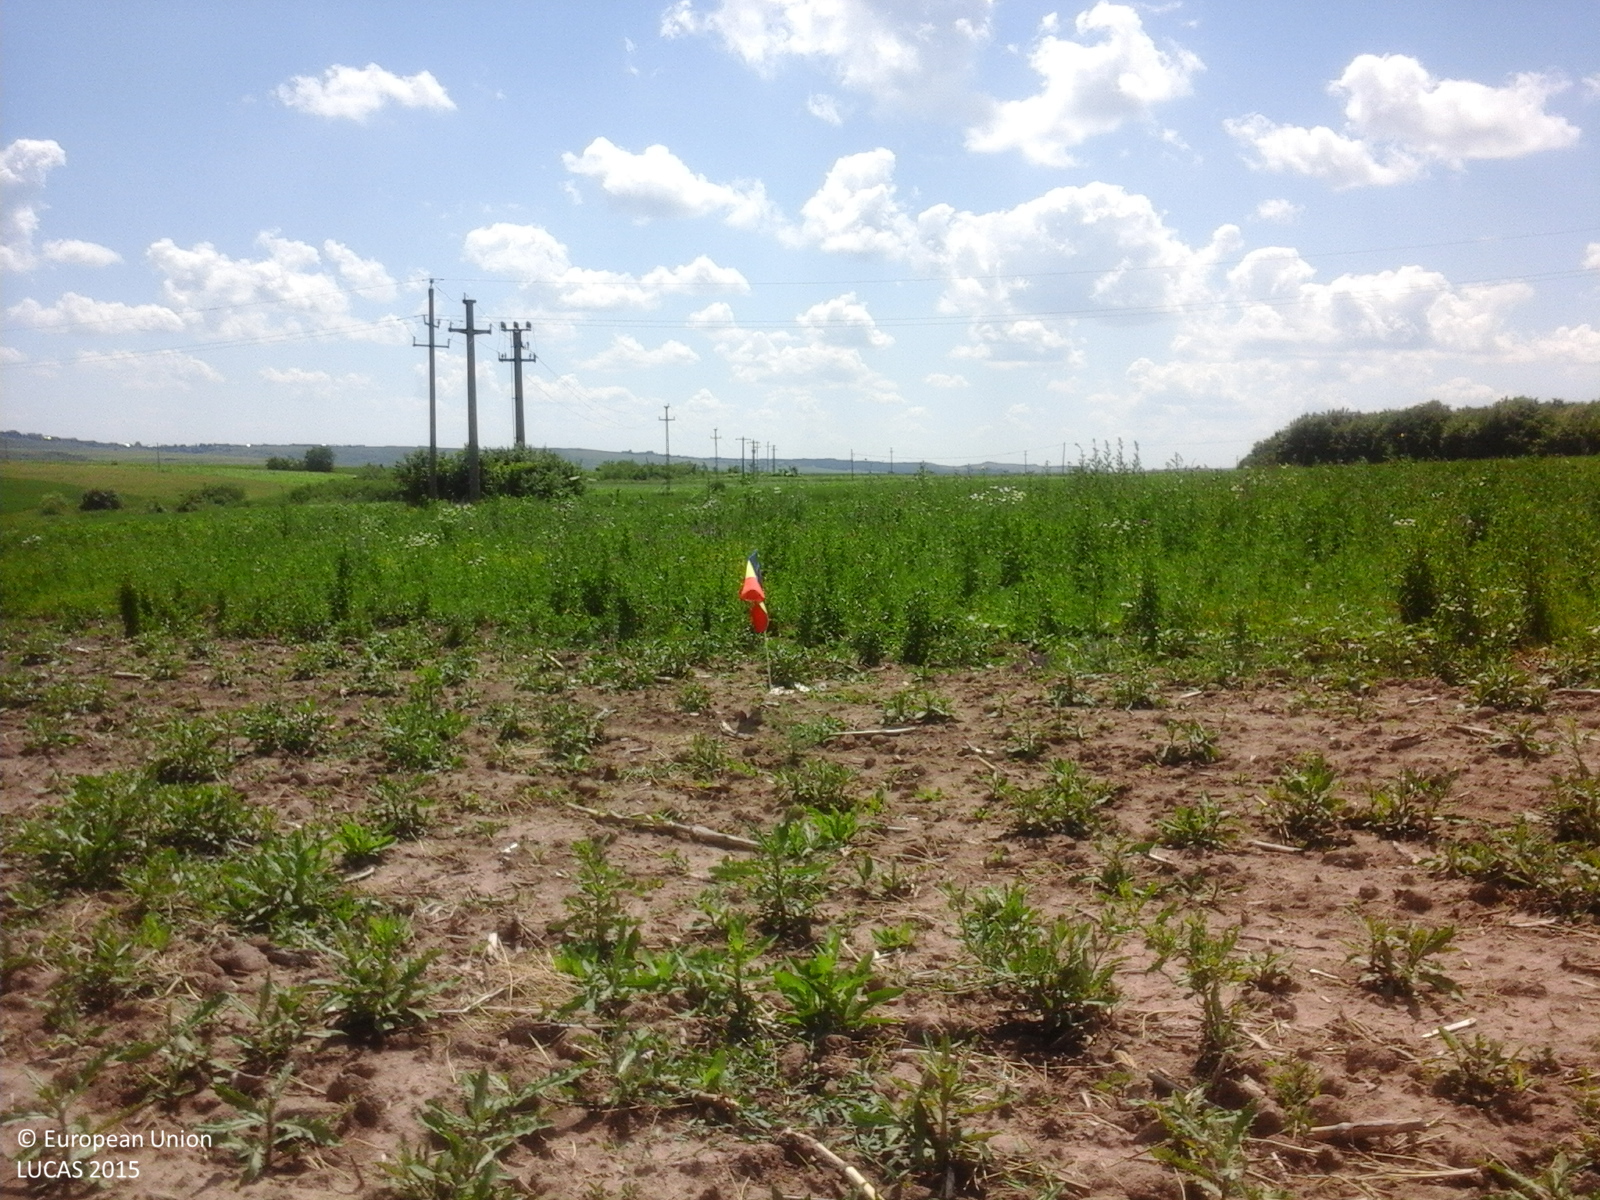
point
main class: Grassland
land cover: Spontaneously vegetated surfaces
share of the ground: 25 - 50 %
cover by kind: unconsolidated bare surface 60 %, herbaceous plants 40 %
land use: Fallow land
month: June
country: RO
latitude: 47.0581
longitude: 27.0995
